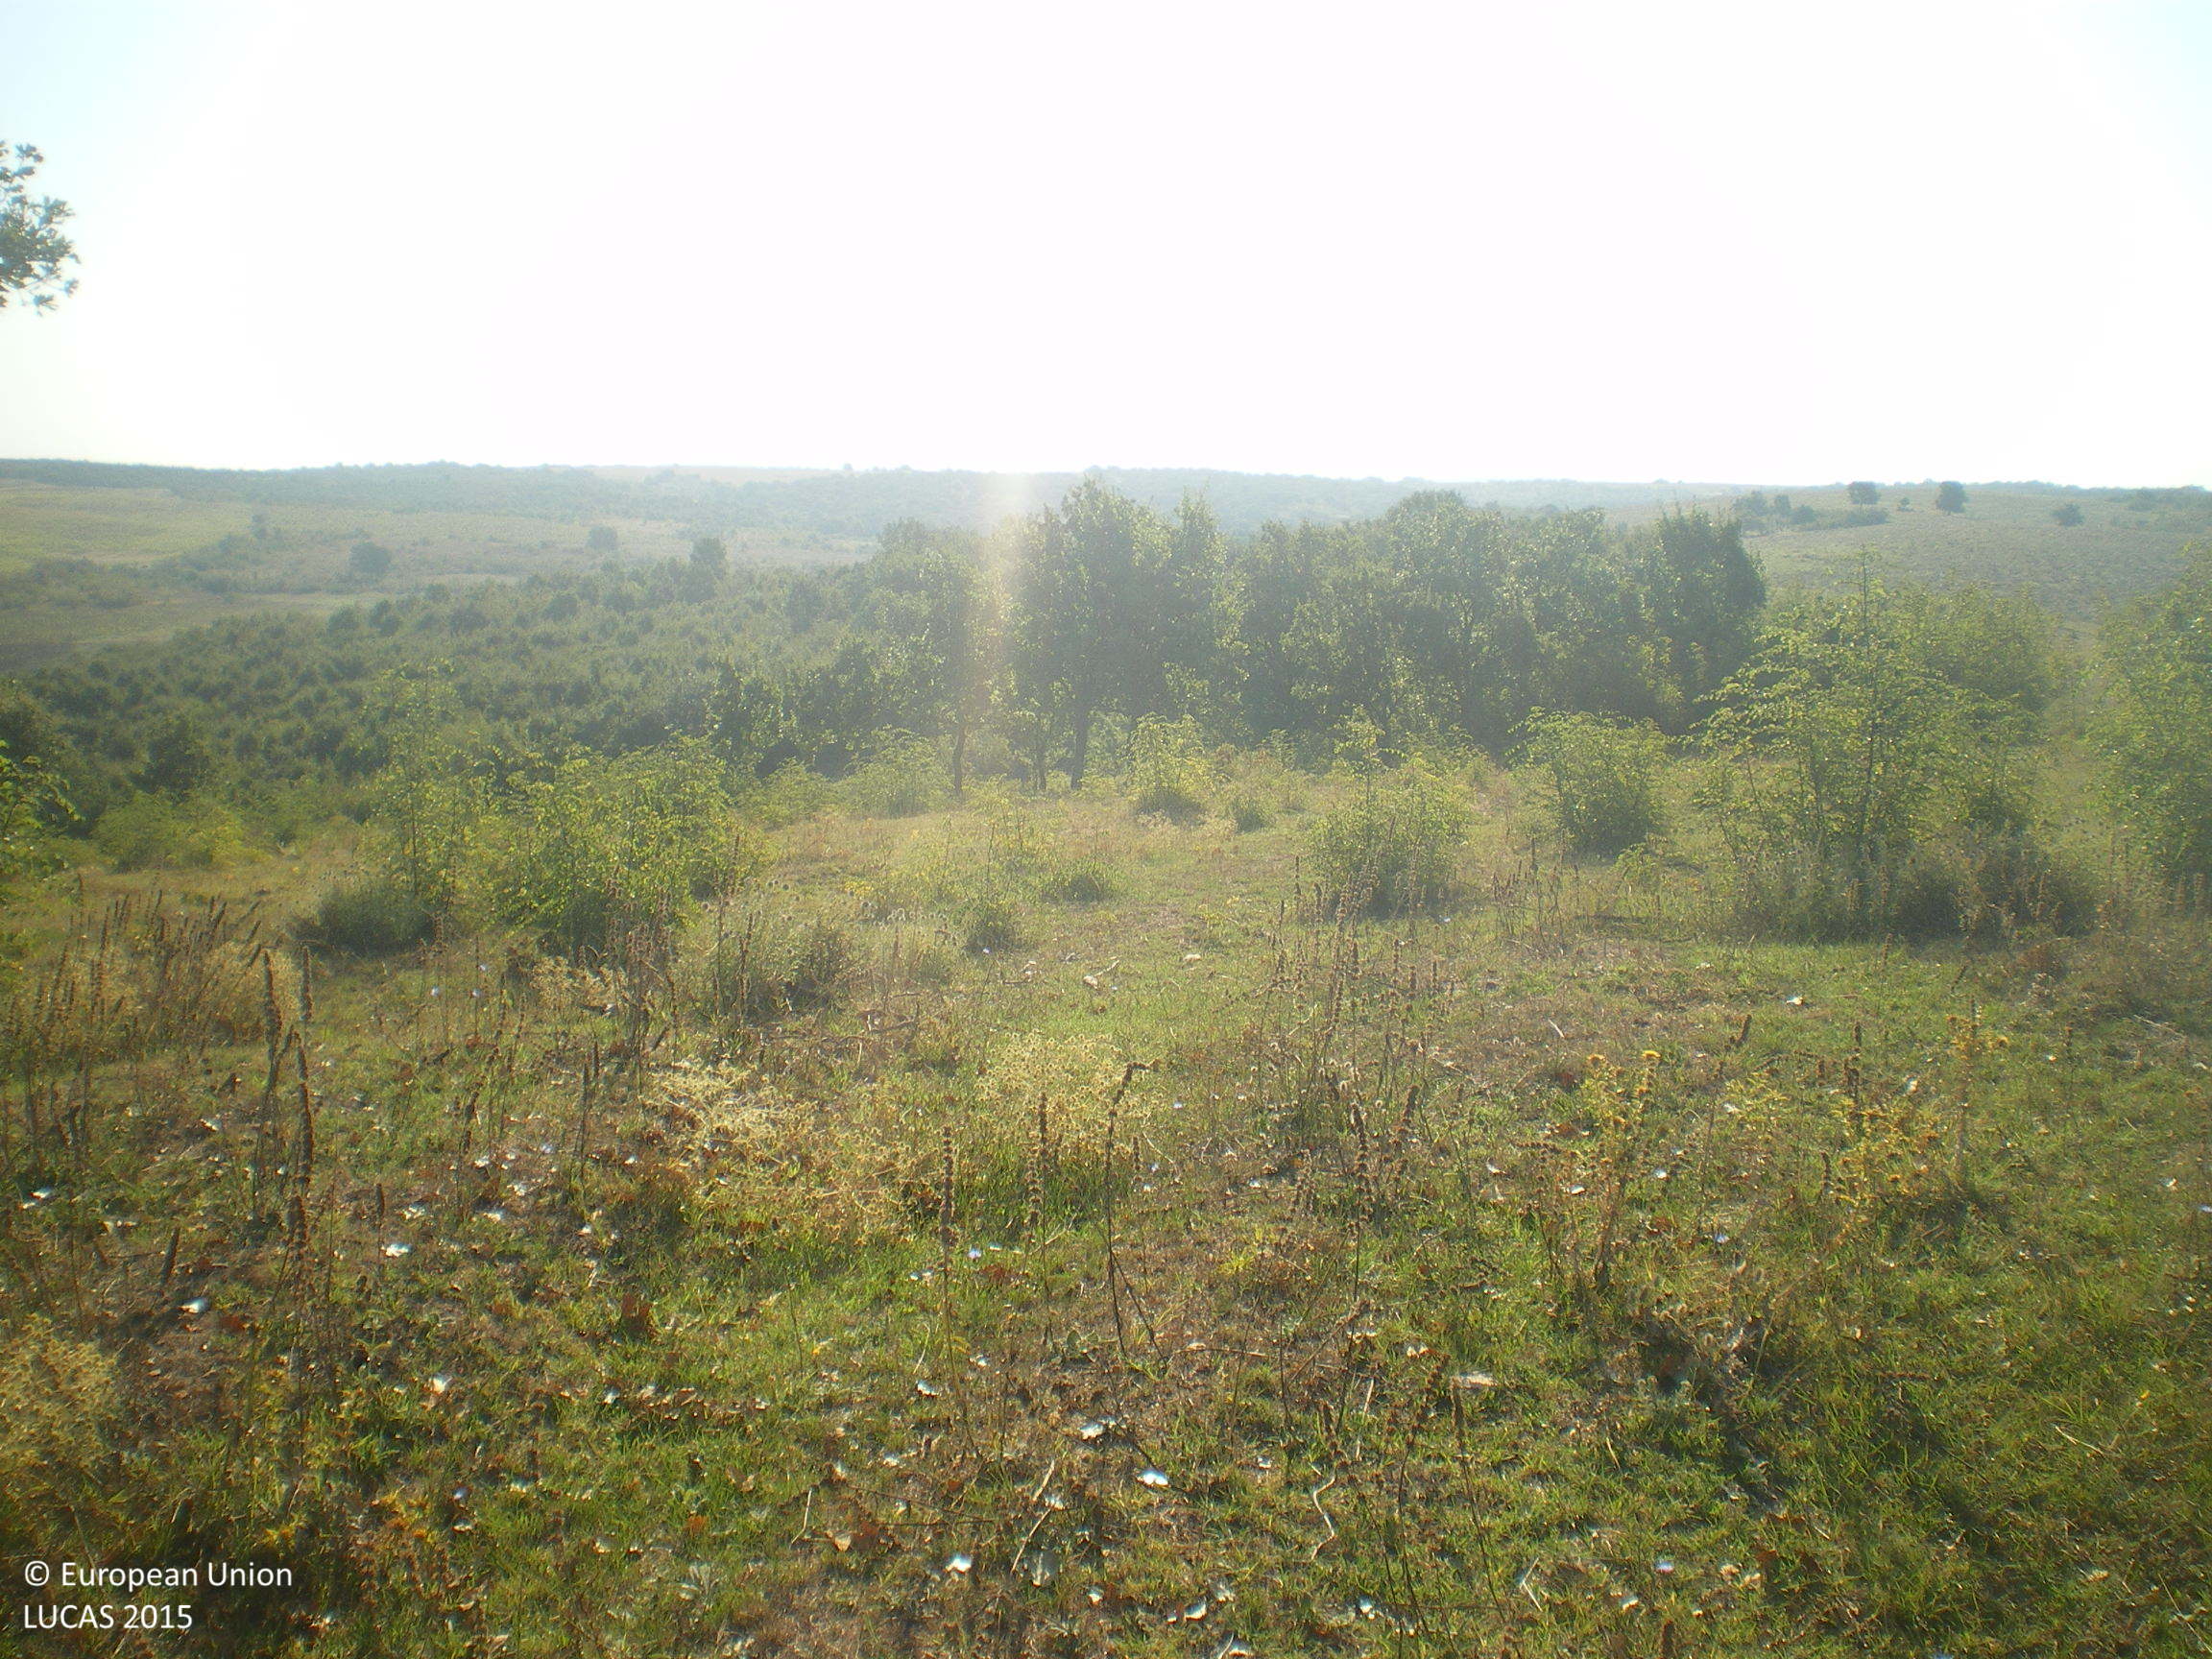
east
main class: Grassland
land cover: Grassland with sparse tree/shrub cover
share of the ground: > 75 %
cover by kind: herbaceous plants 85 %, shrubs 10 %, broadleaved forest trees 5 %
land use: Agriculture (excluding fallow land and kitchen gardens)
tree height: > 5 m
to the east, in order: Grassland with sparse tree/shrub cover; Tracks; Broadleaved woodland
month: August
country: BG
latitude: 42.0619
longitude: 25.9409
